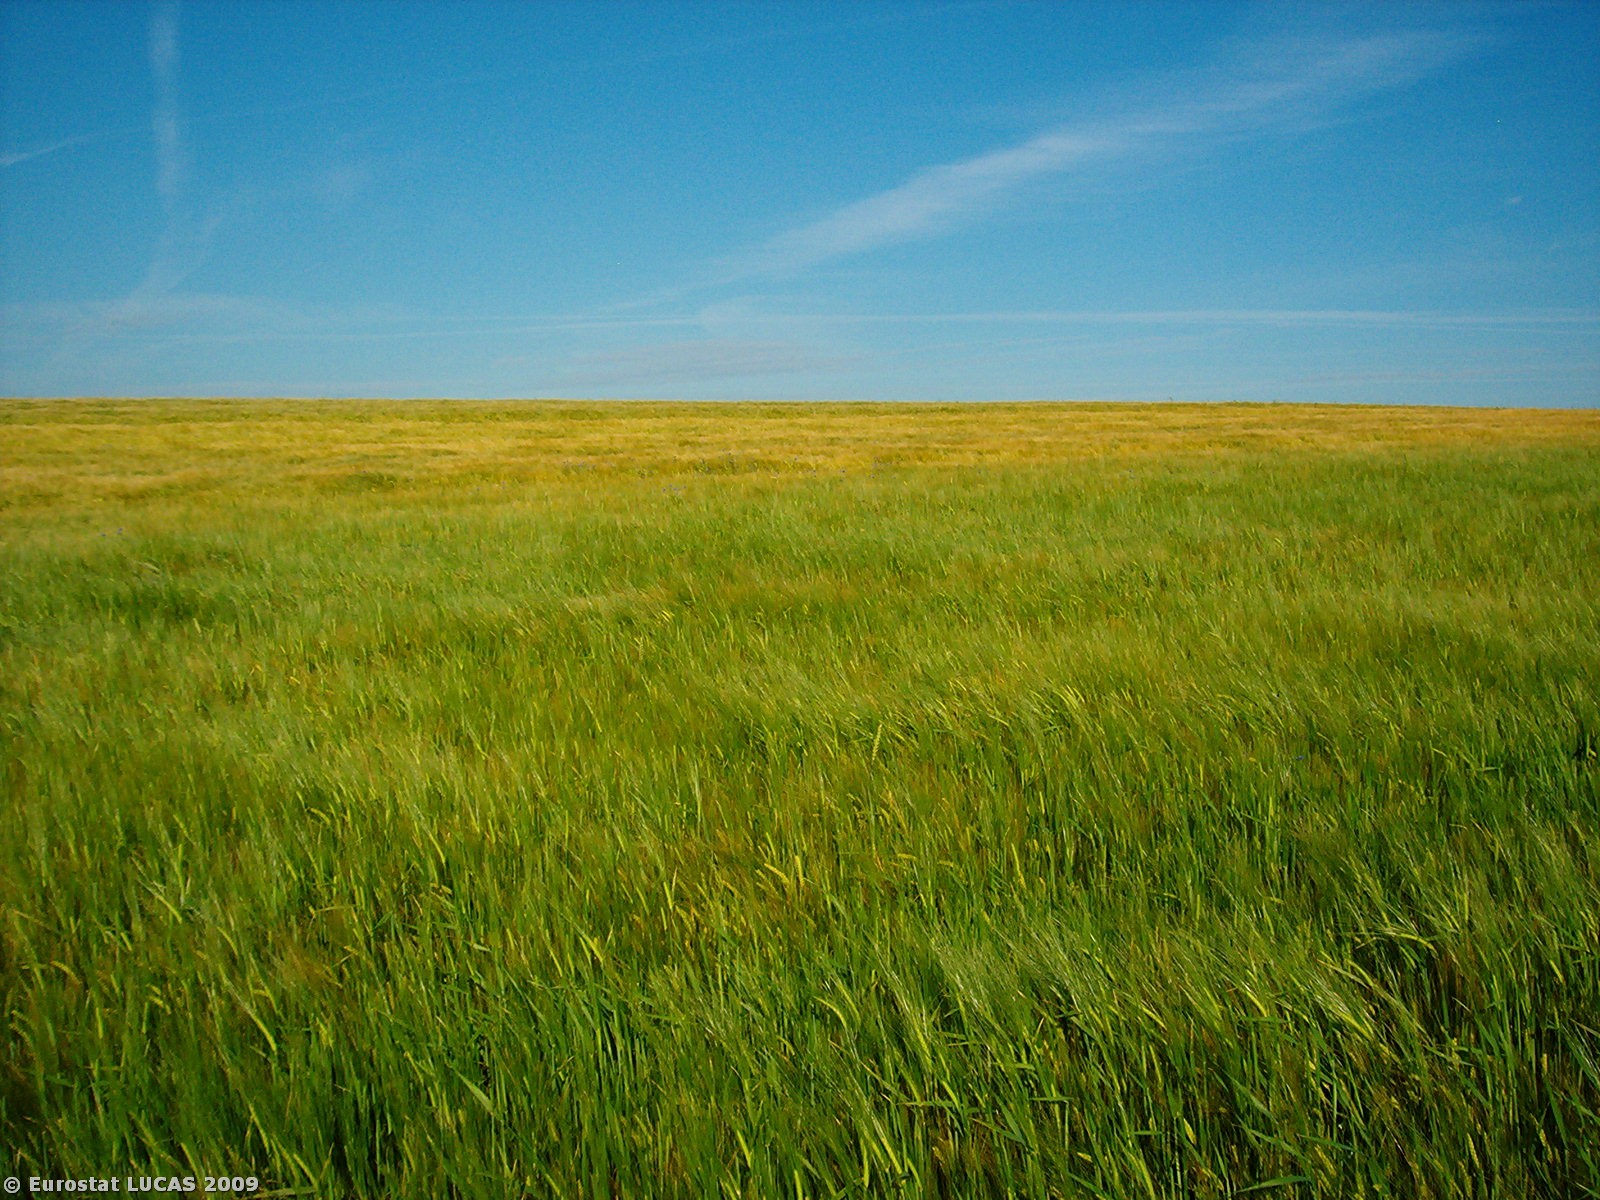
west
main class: Cropland
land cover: Barley
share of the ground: > 75 %
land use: Agriculture (excluding fallow land and kitchen gardens)
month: June
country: PL
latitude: 53.9668
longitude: 15.3836
